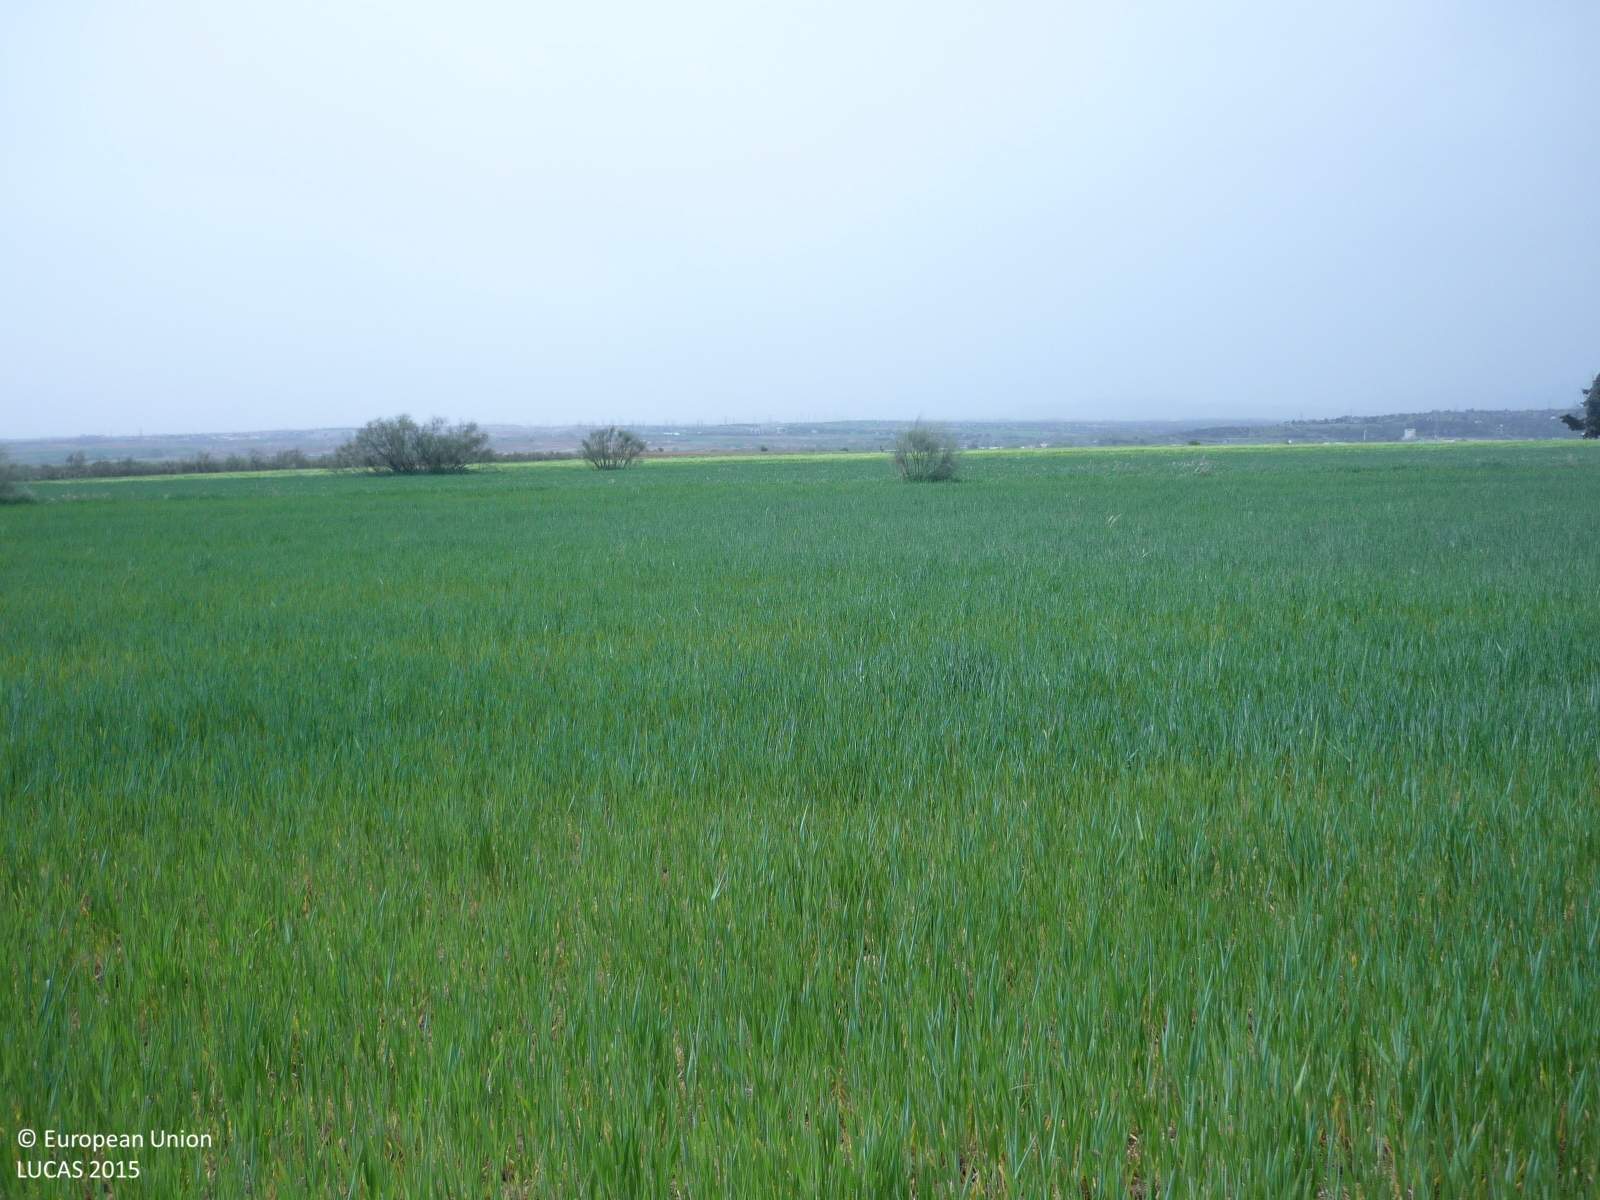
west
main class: Cropland
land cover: Rye
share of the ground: > 75 %
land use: Agriculture (excluding fallow land and kitchen gardens)
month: April
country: ES
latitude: 40.5694
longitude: -3.5384
